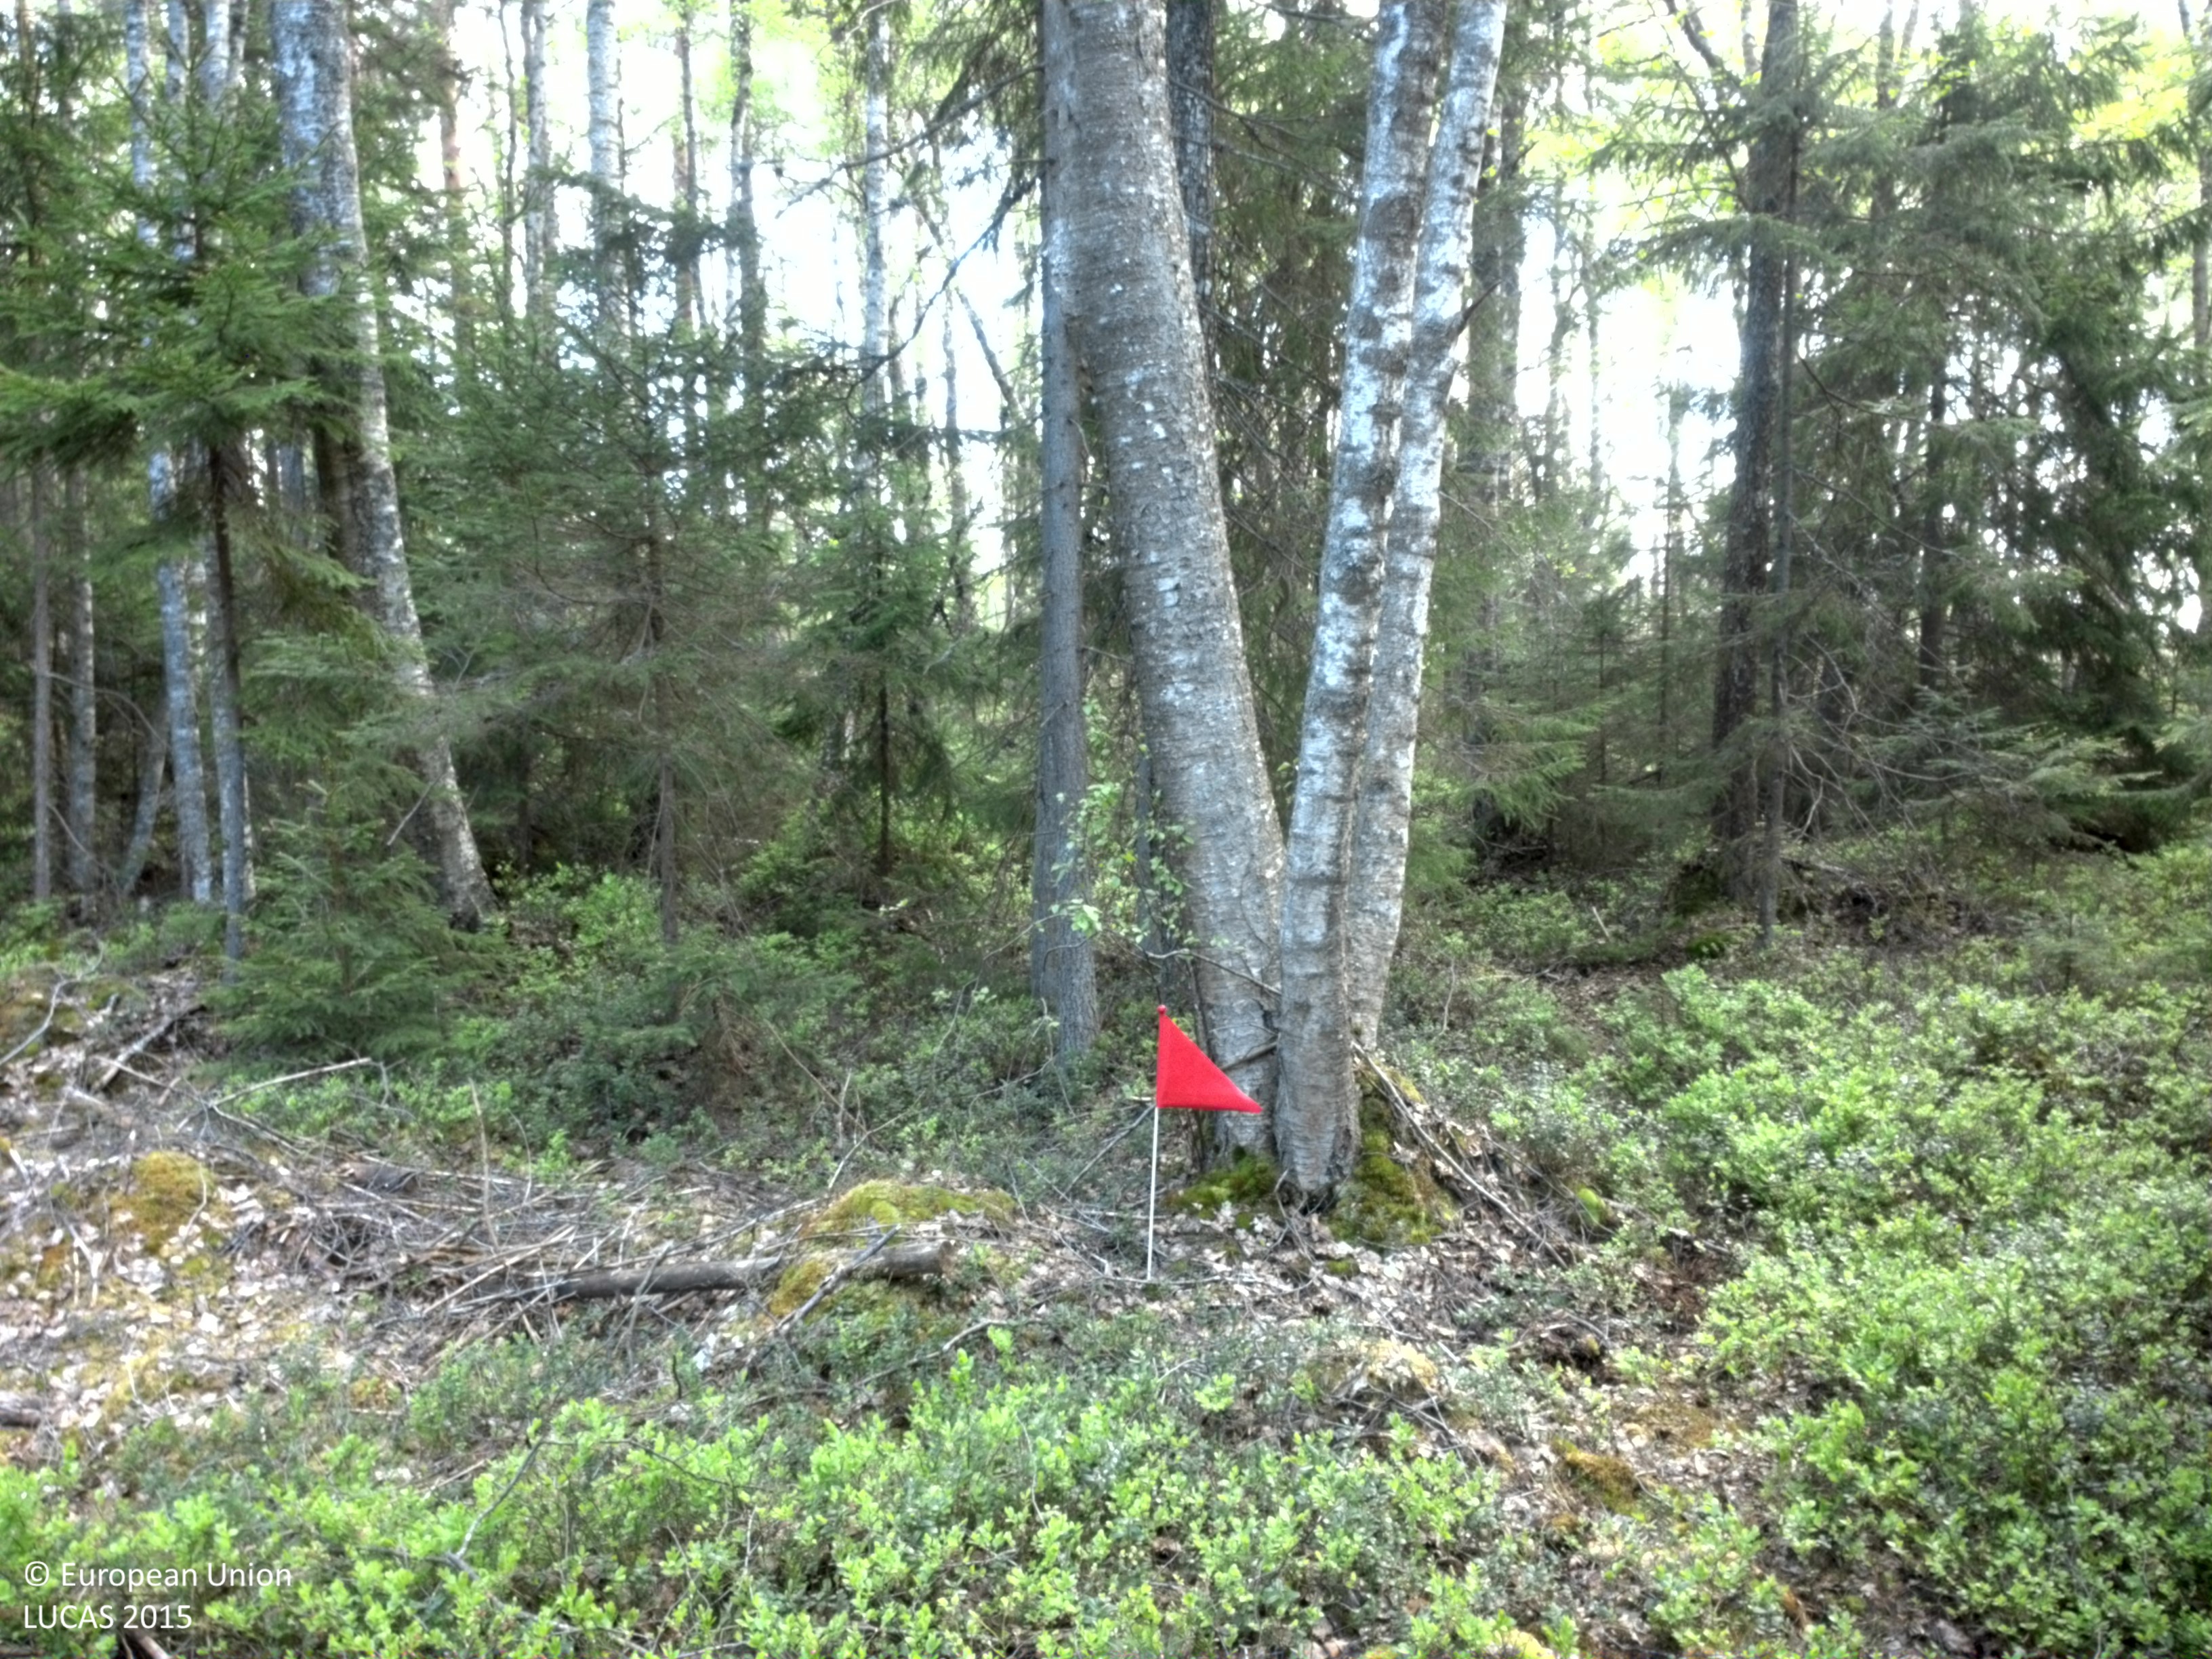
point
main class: Woodland
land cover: Spruce dominated mixed woodland
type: boreal forest
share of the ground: 50 - 75 %
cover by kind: broadleaved forest trees 50 %, coniferous forest trees 20 %, lichens and mosses 20 %, herbaceous plants 10 %
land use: Forestry
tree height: > 5 m
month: May
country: SE
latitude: 56.7512
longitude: 15.1493
